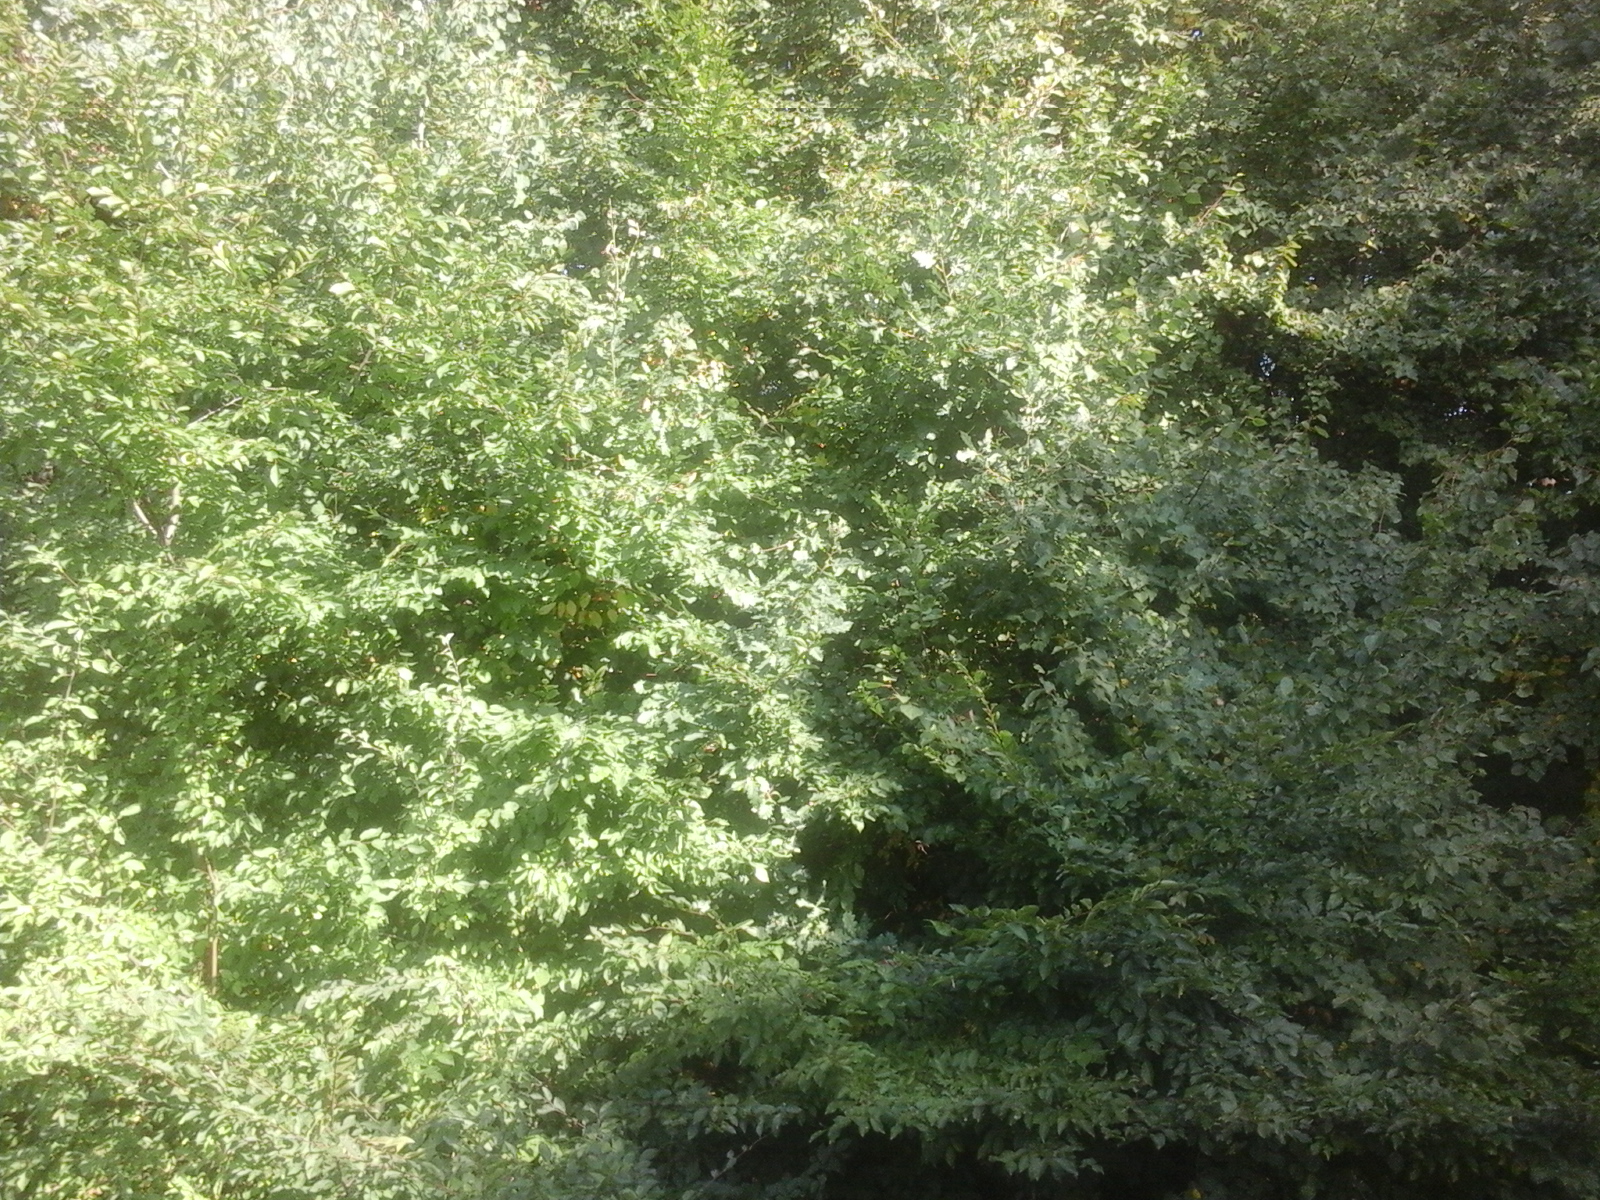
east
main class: Woodland
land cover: Broadleaved woodland
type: beech forest
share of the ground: > 75 %
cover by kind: broadleaved forest trees 100 %
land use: Forestry
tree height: > 5 m
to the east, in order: Broadleaved woodland; Other bare soil; Electric lines; Other bare soil; Fences; Shruby margins; Ditches and canals; Paved roads, cycling and walking lanes; Ditches and canals; Abandoned hedges; Electric lines; Abandoned hedges; Grassland without tree/shrub cover; Shrubland with sparse tree cover; Grassland without tree/shrub cover
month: September
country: RO
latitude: 47.1128
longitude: 24.4953
